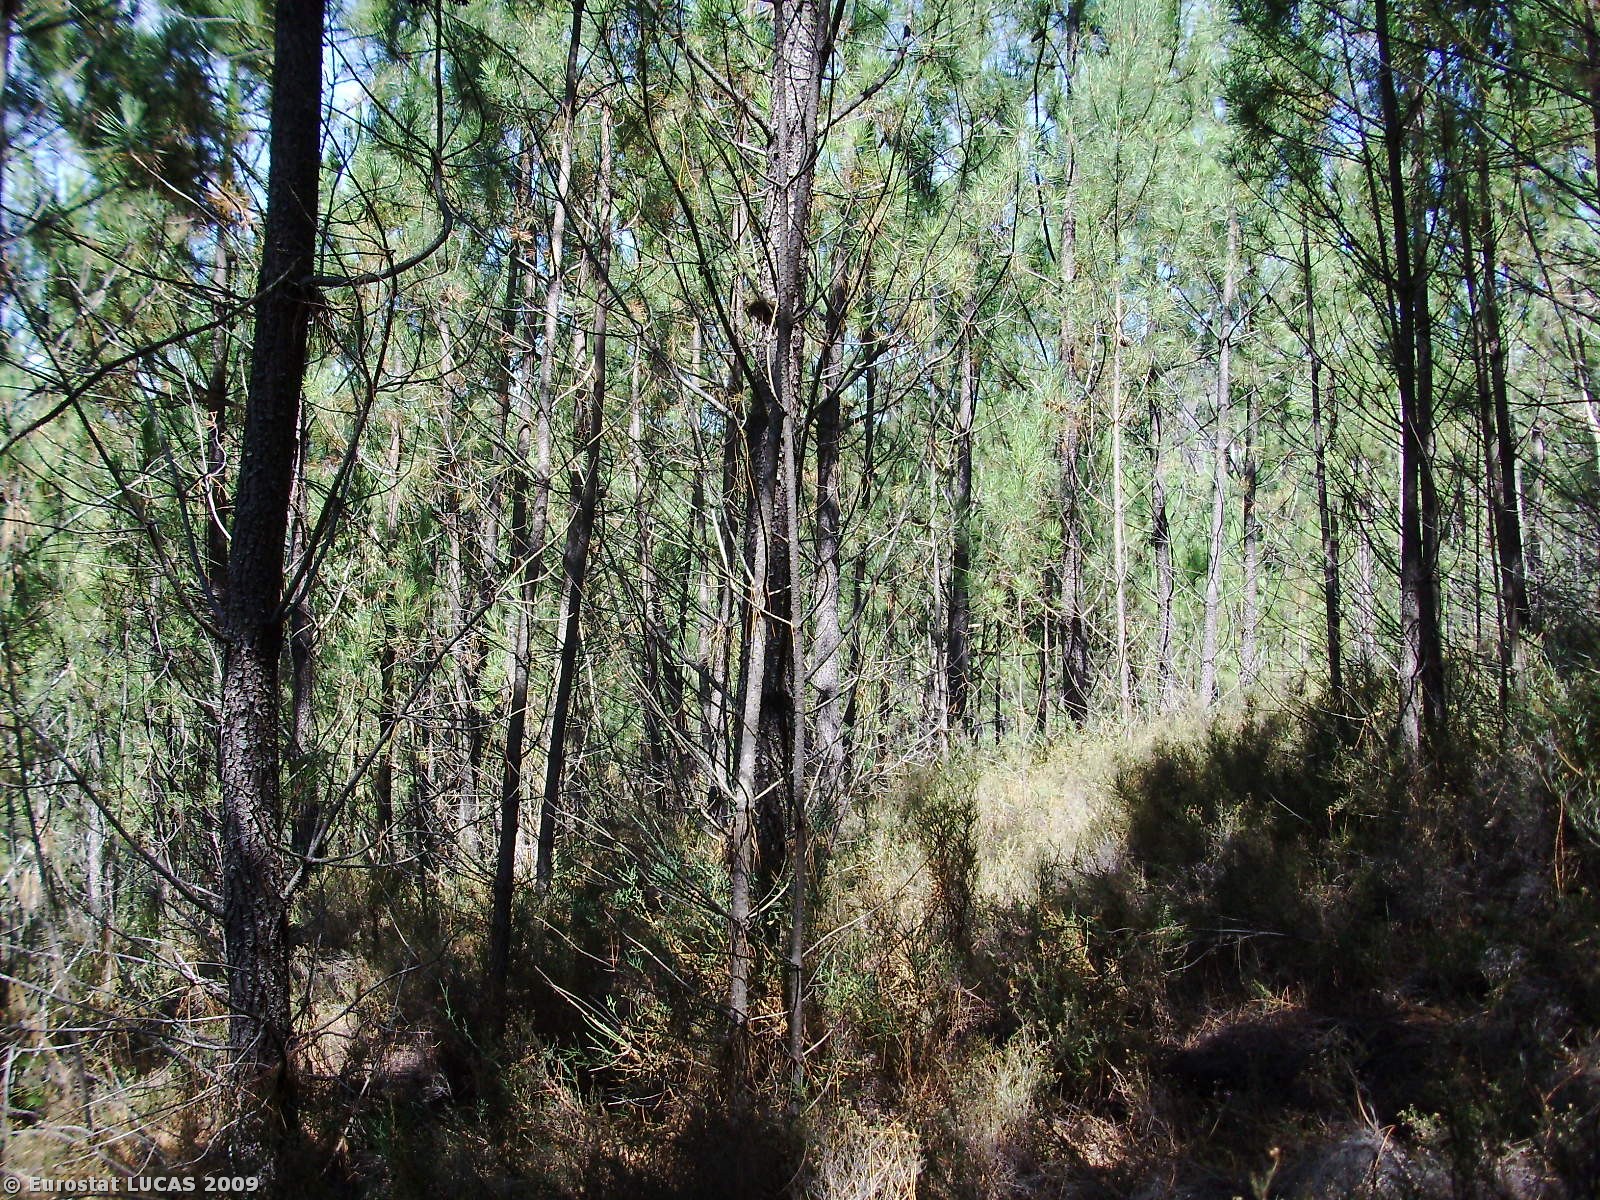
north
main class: Woodland
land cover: Coniferous woodland
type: coniferous forest of the mediterranean region
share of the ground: > 75 %
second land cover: Shrubland with sparse tree cover
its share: 10 - 25 %
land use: Forestry
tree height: > 5 m
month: August
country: PT
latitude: 40.0318
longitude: -8.1789
